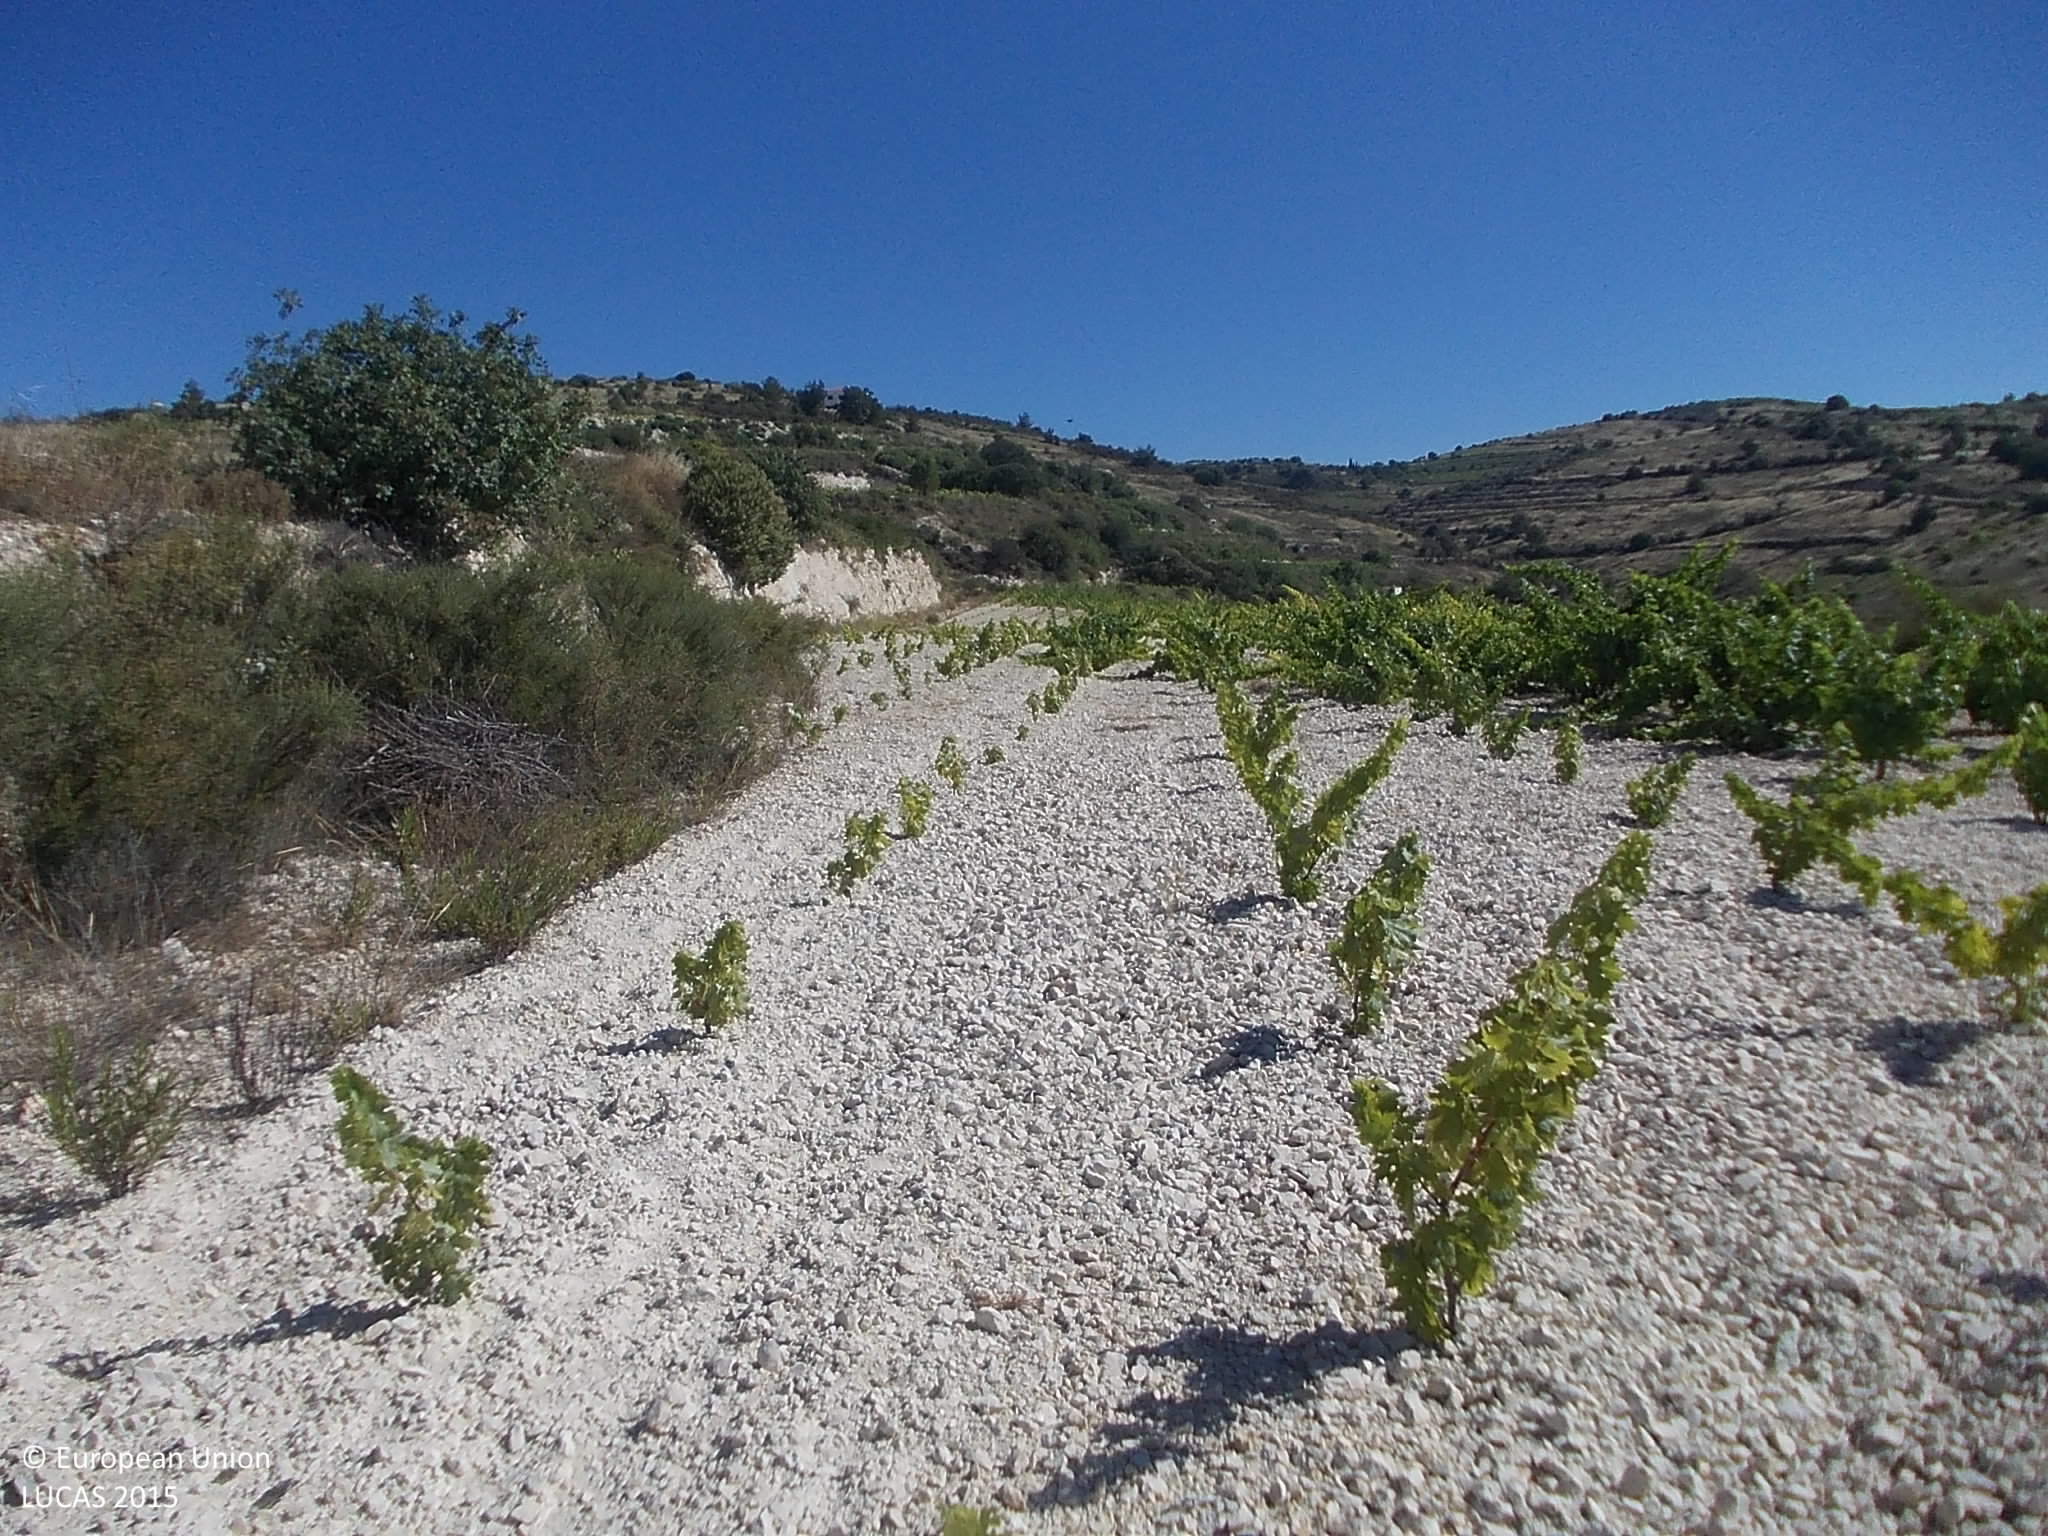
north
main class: Cropland
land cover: Vineyards
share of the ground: 10 - 25 %
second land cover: Rocks and stones
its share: > 75 %
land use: Agriculture (excluding fallow land and kitchen gardens)
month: July
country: CY
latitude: 34.8531
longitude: 32.7673
